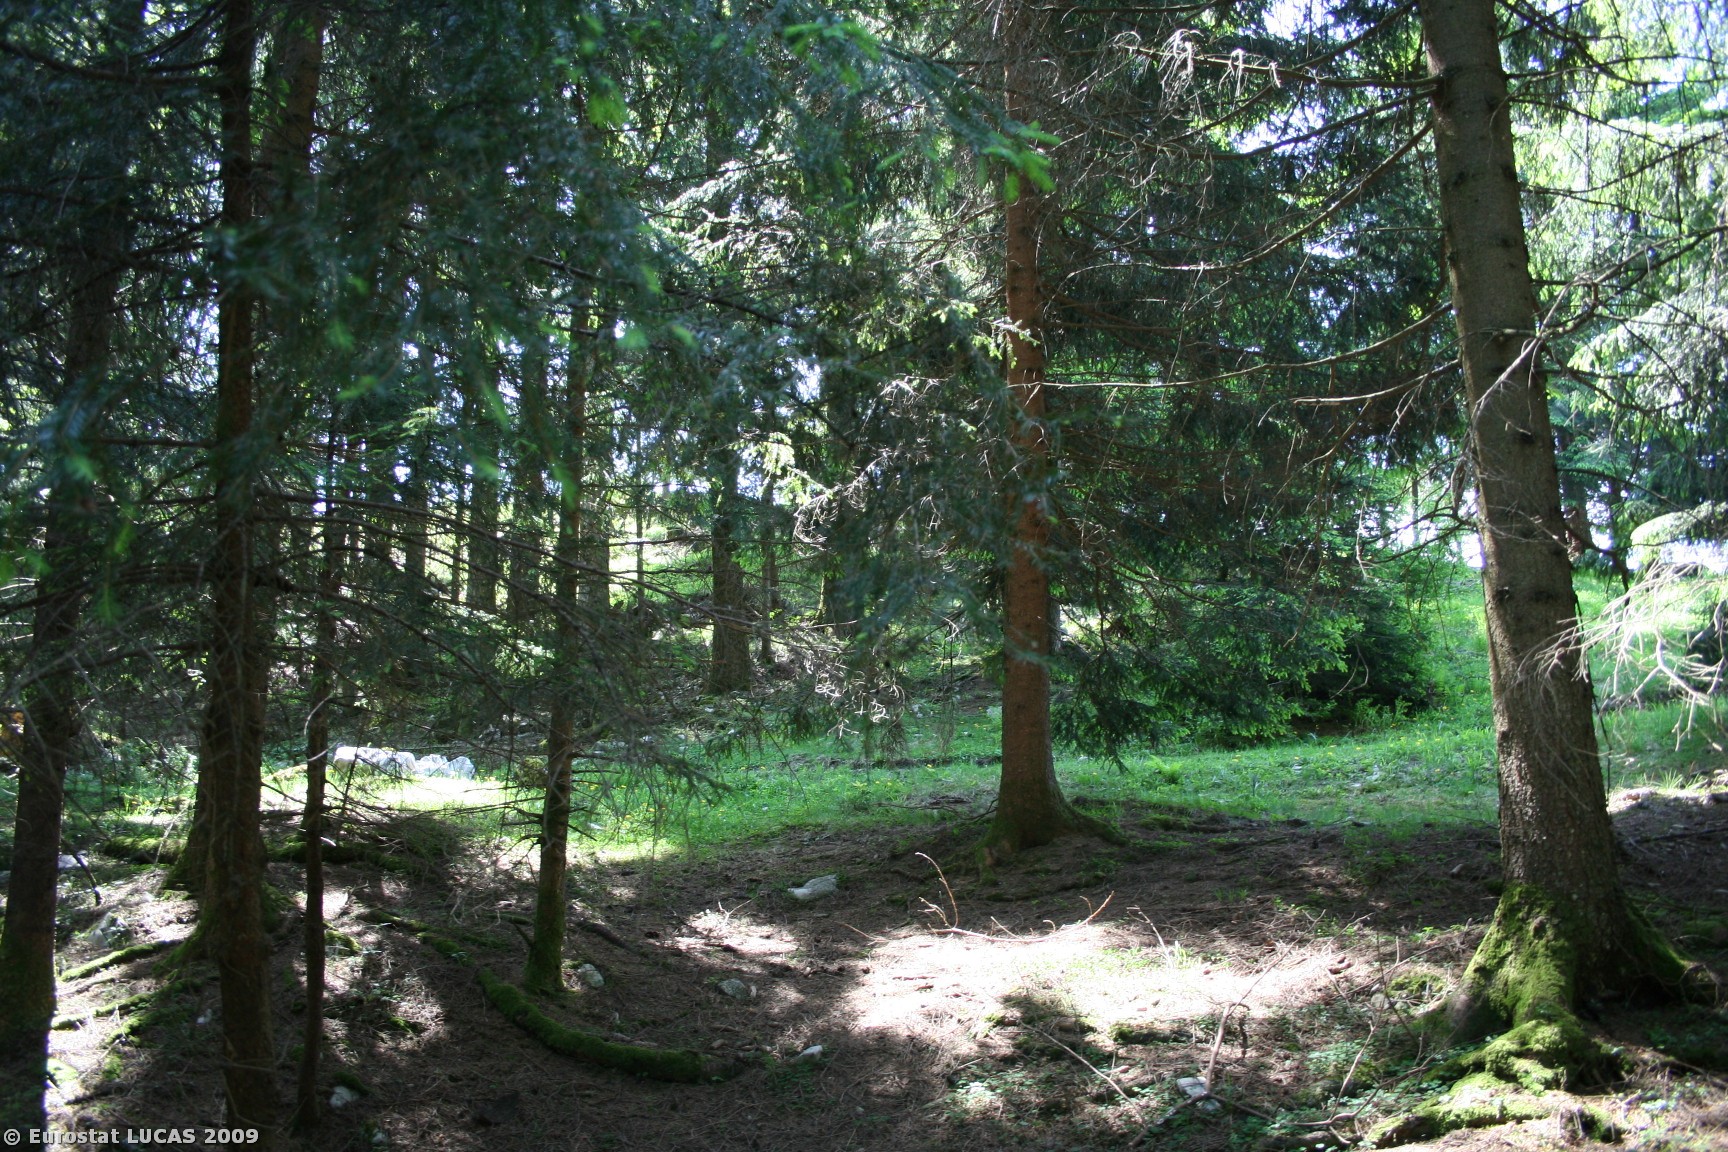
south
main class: Woodland
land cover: Coniferous woodland
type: alpine coniferous forest
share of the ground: > 75 %
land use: Forestry
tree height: > 5 m
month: May
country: AT
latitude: 47.6546
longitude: 13.2072
